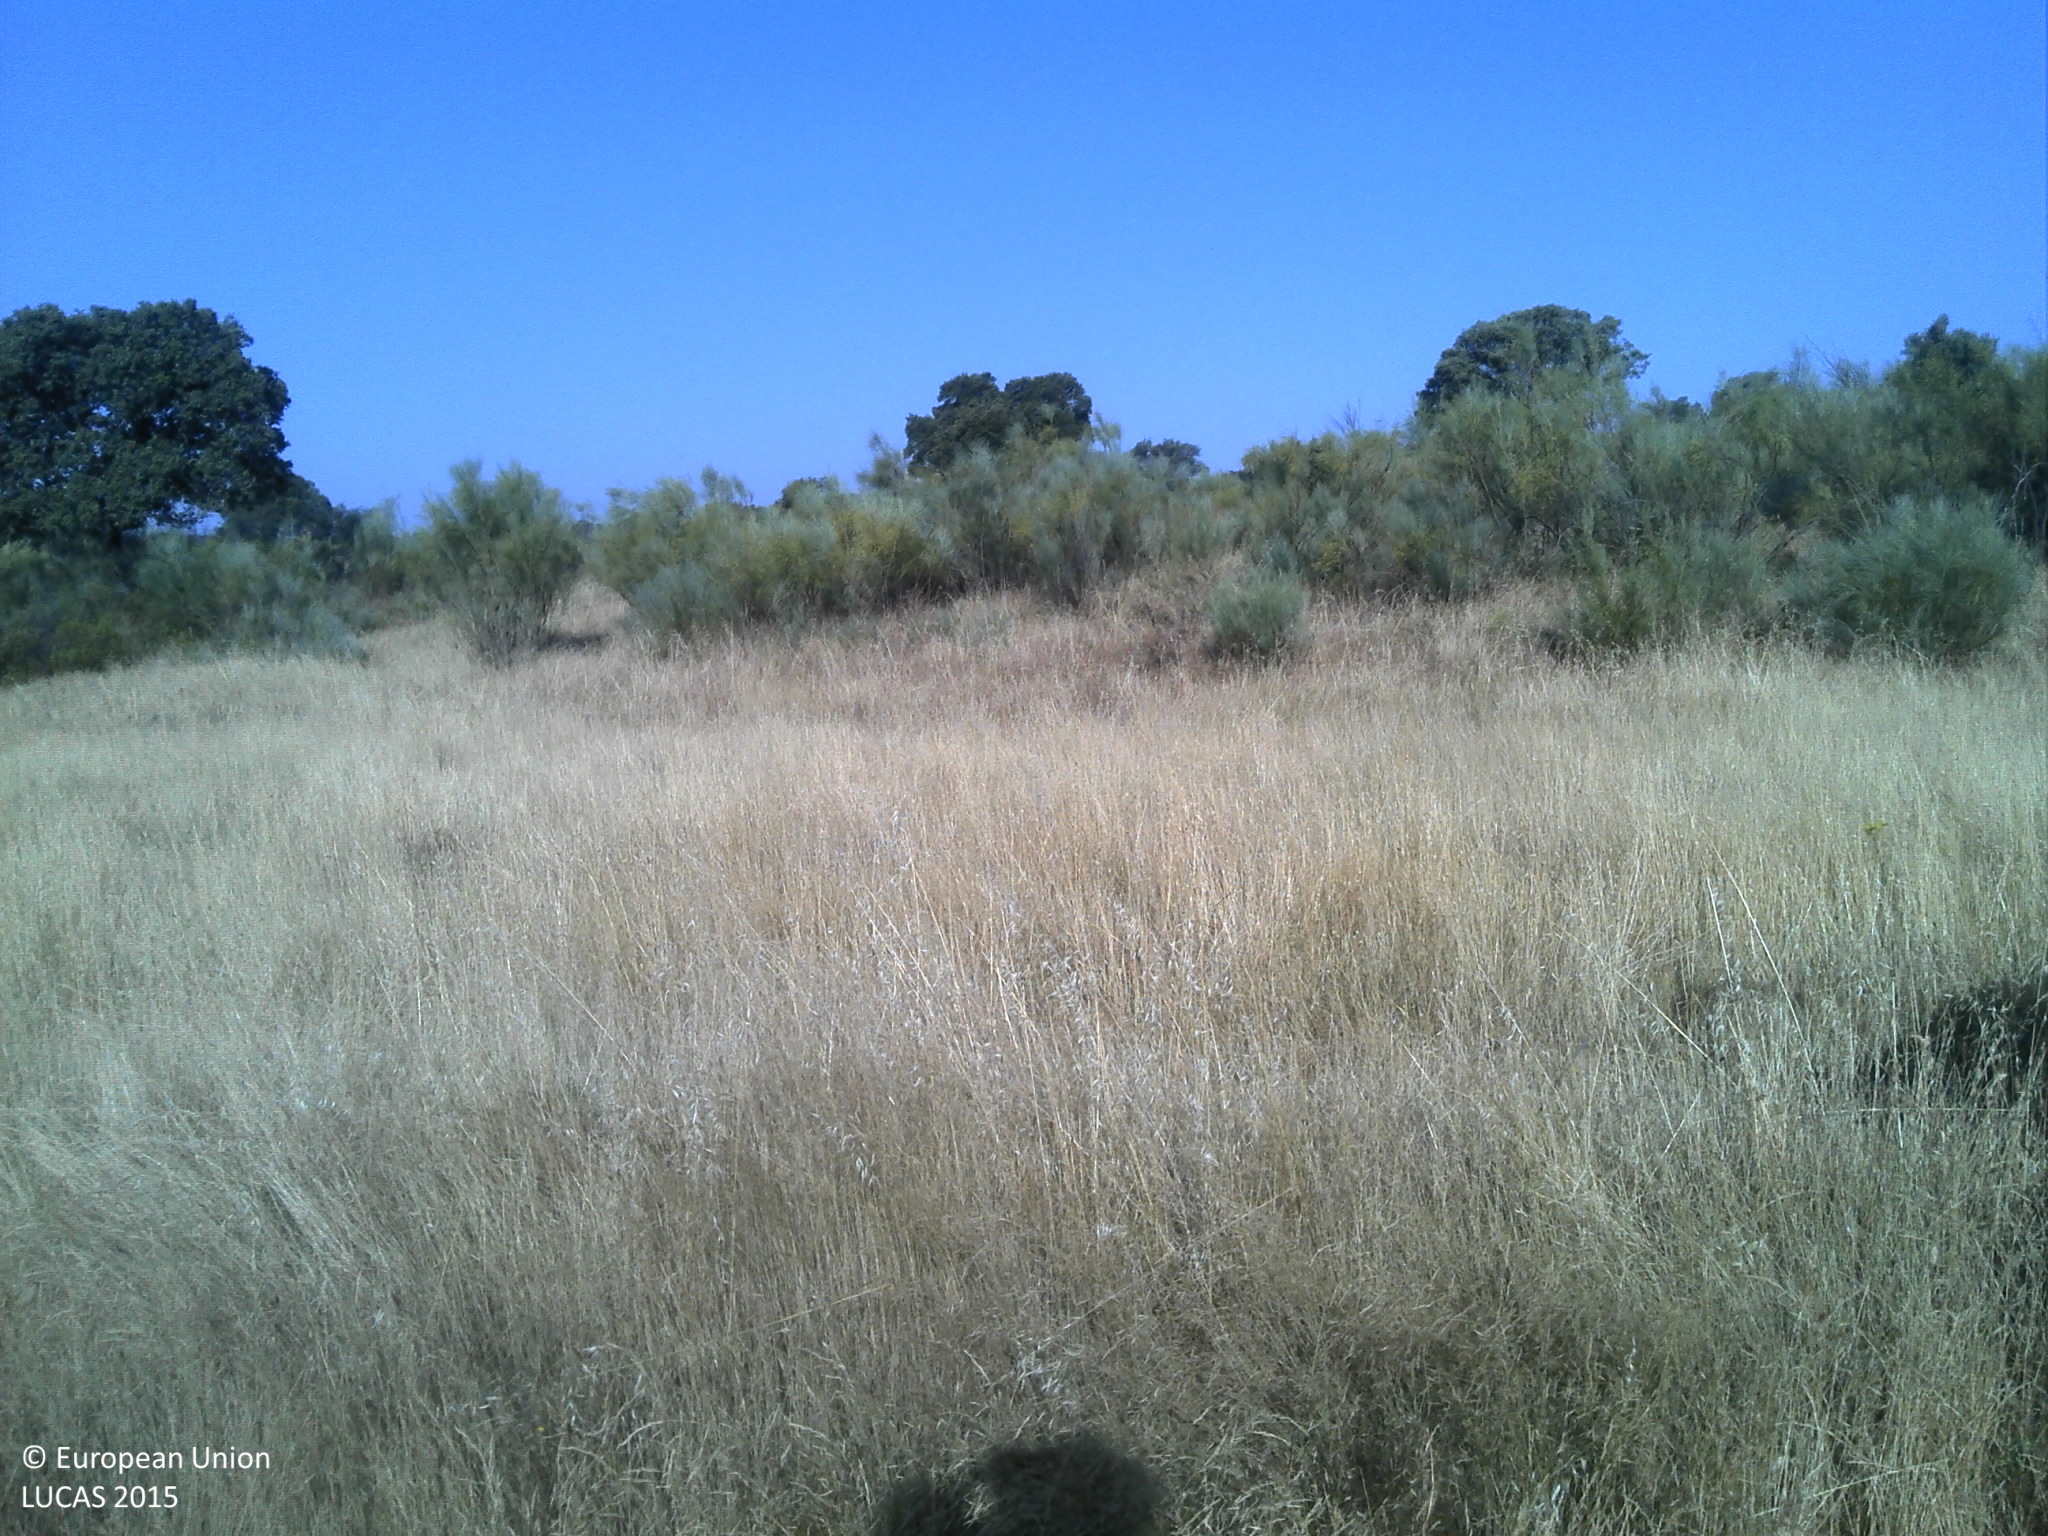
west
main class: Grassland
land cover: Grassland without tree/shrub cover
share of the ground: 50 - 75 %
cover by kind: herbaceous plants 65 %, unconsolidated bare surface 25 %, shrubs 5 %
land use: Agriculture (excluding fallow land and kitchen gardens)
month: June
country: PT
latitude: 39.7155
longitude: -7.0834
